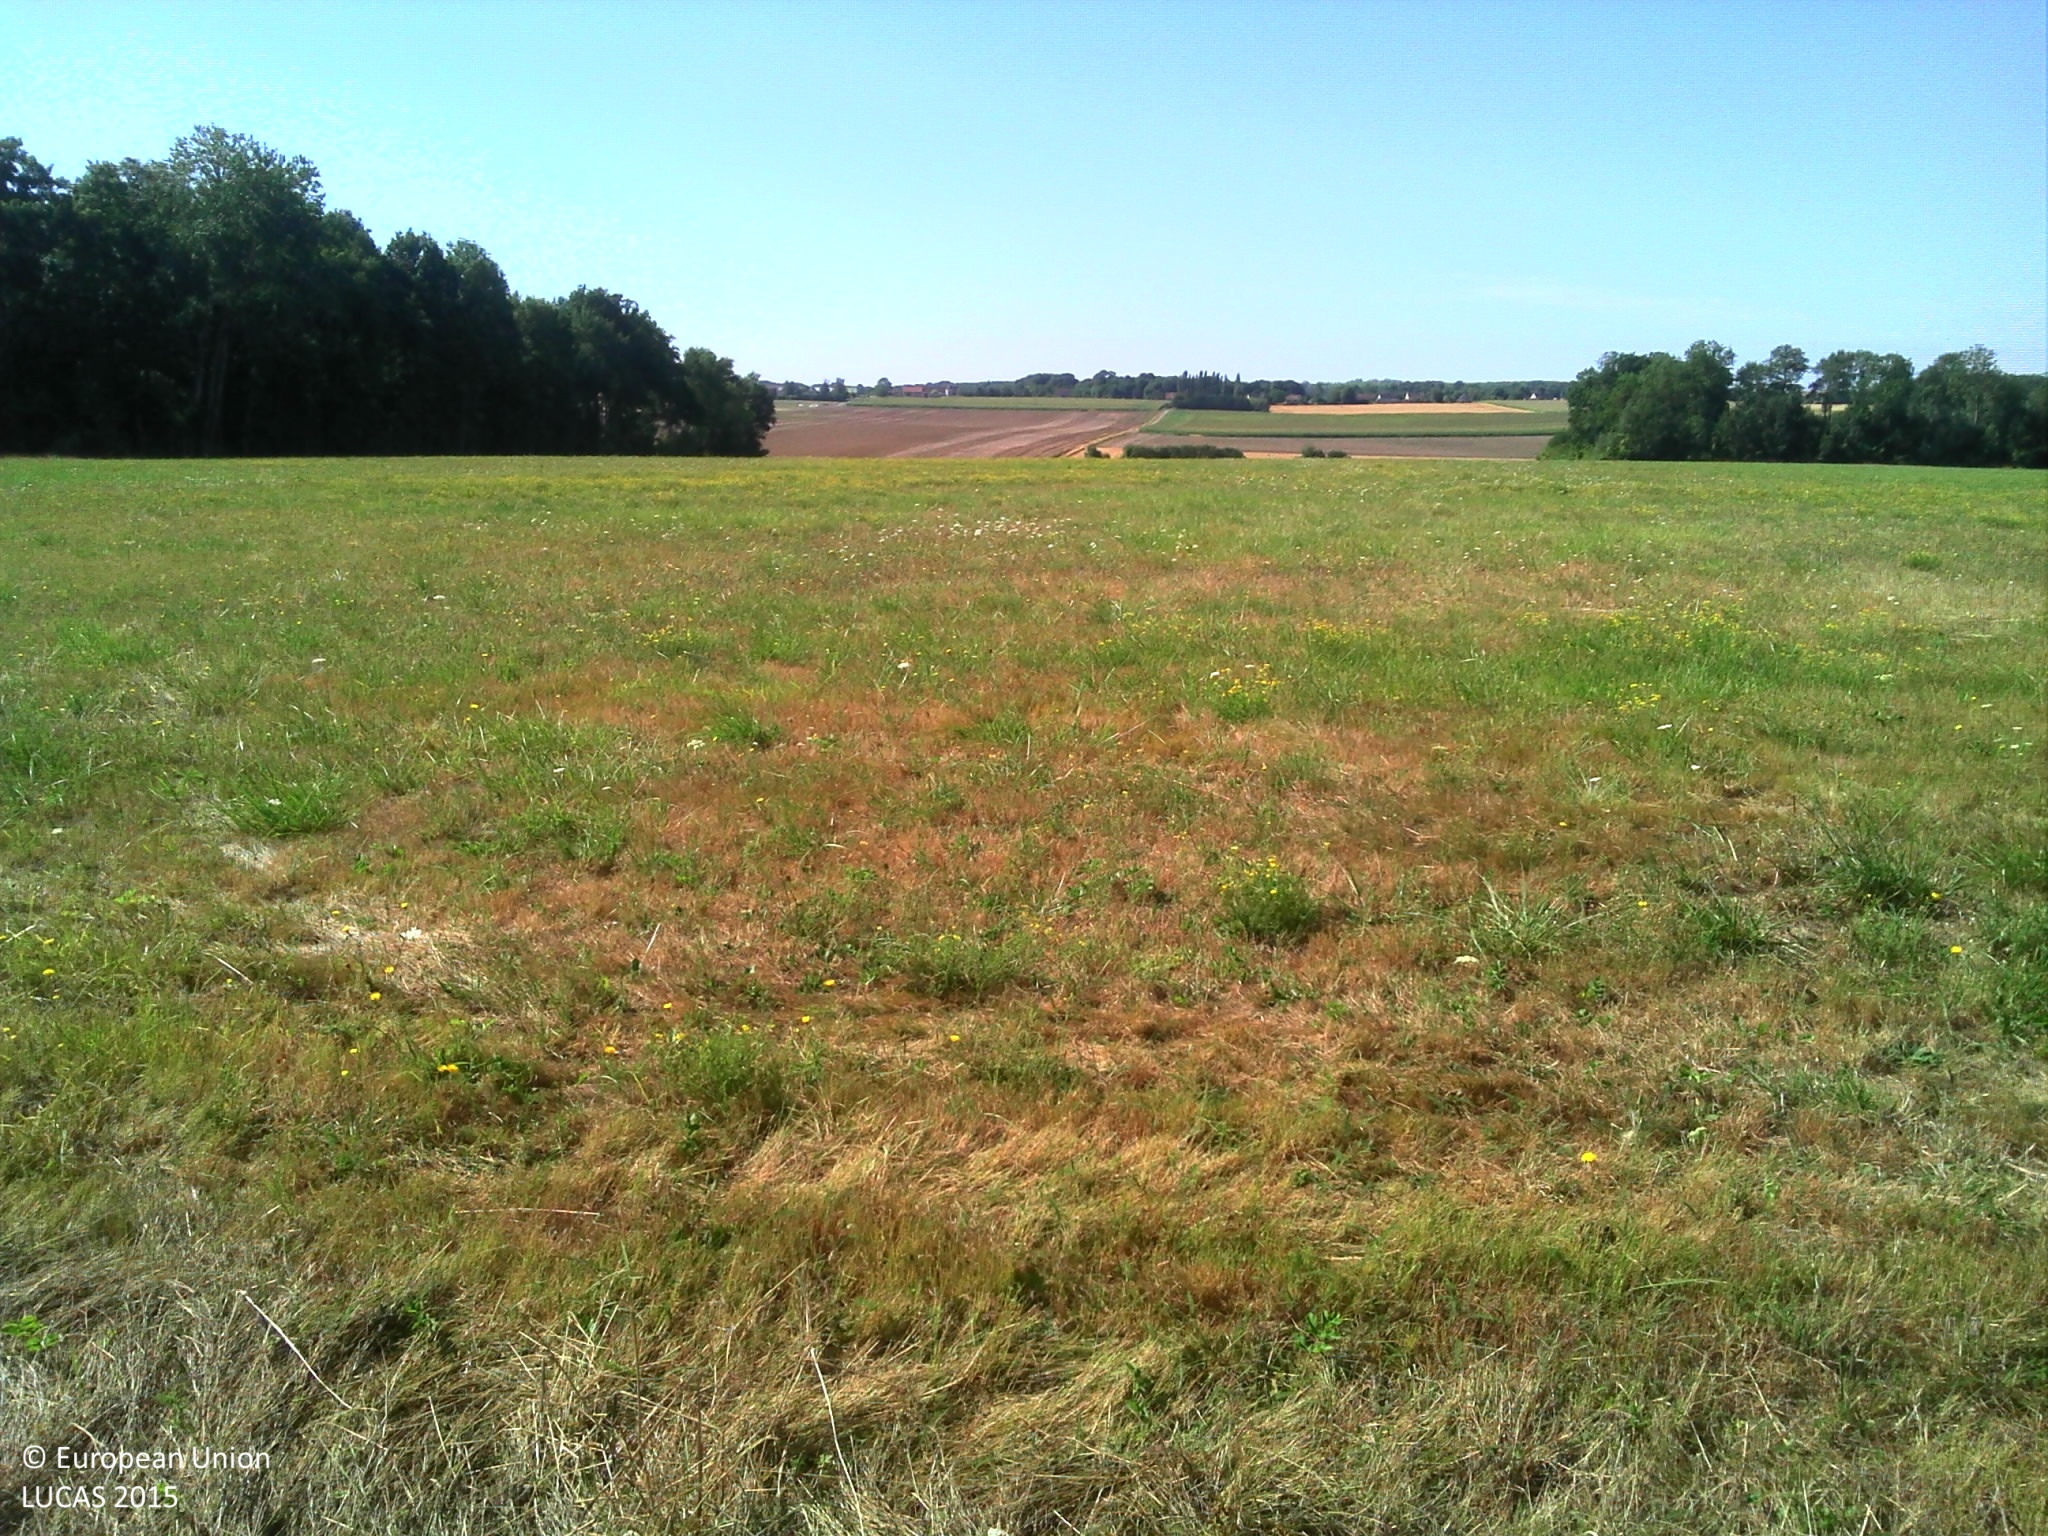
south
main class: Artificial land
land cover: Non built-up linear features
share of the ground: > 75 %
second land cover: Grassland without tree/shrub cover
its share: > 75 %
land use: Road transport
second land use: Agriculture (excluding fallow land and kitchen gardens)
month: August
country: FR
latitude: 48.7444
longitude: 3.3429
